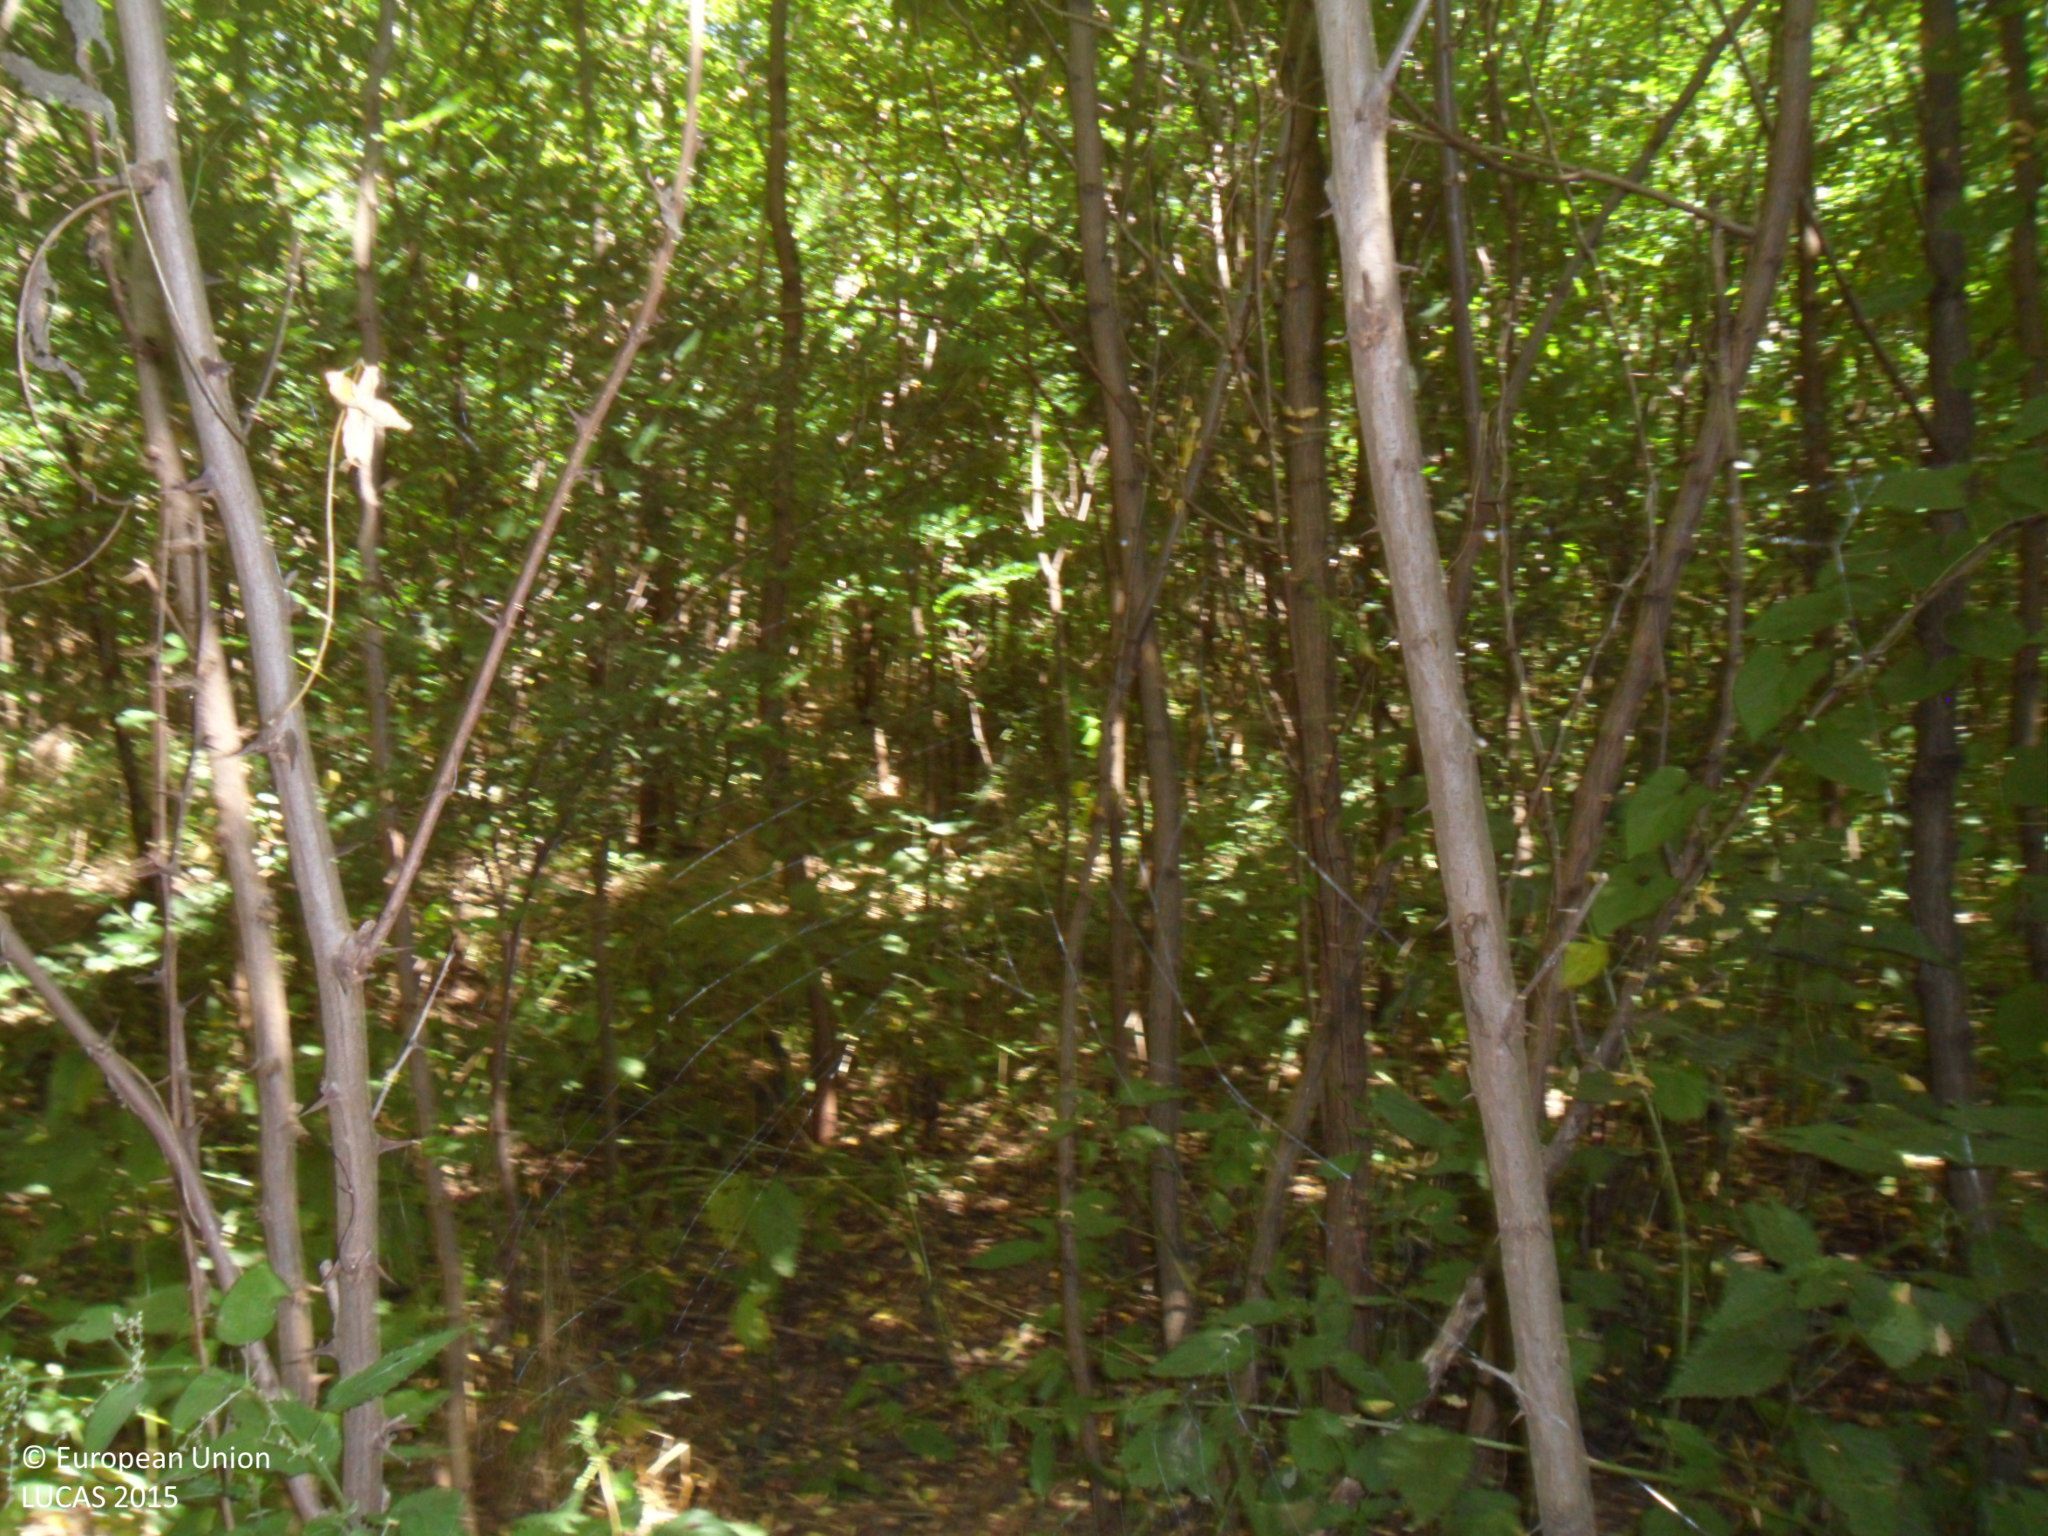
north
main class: Woodland
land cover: Broadleaved woodland
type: mesophytic deciduous forest
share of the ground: > 75 %
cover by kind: broadleaved forest trees 100 %
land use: Forestry
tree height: > 5 m
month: July
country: BG
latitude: 43.8279
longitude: 26.3829
